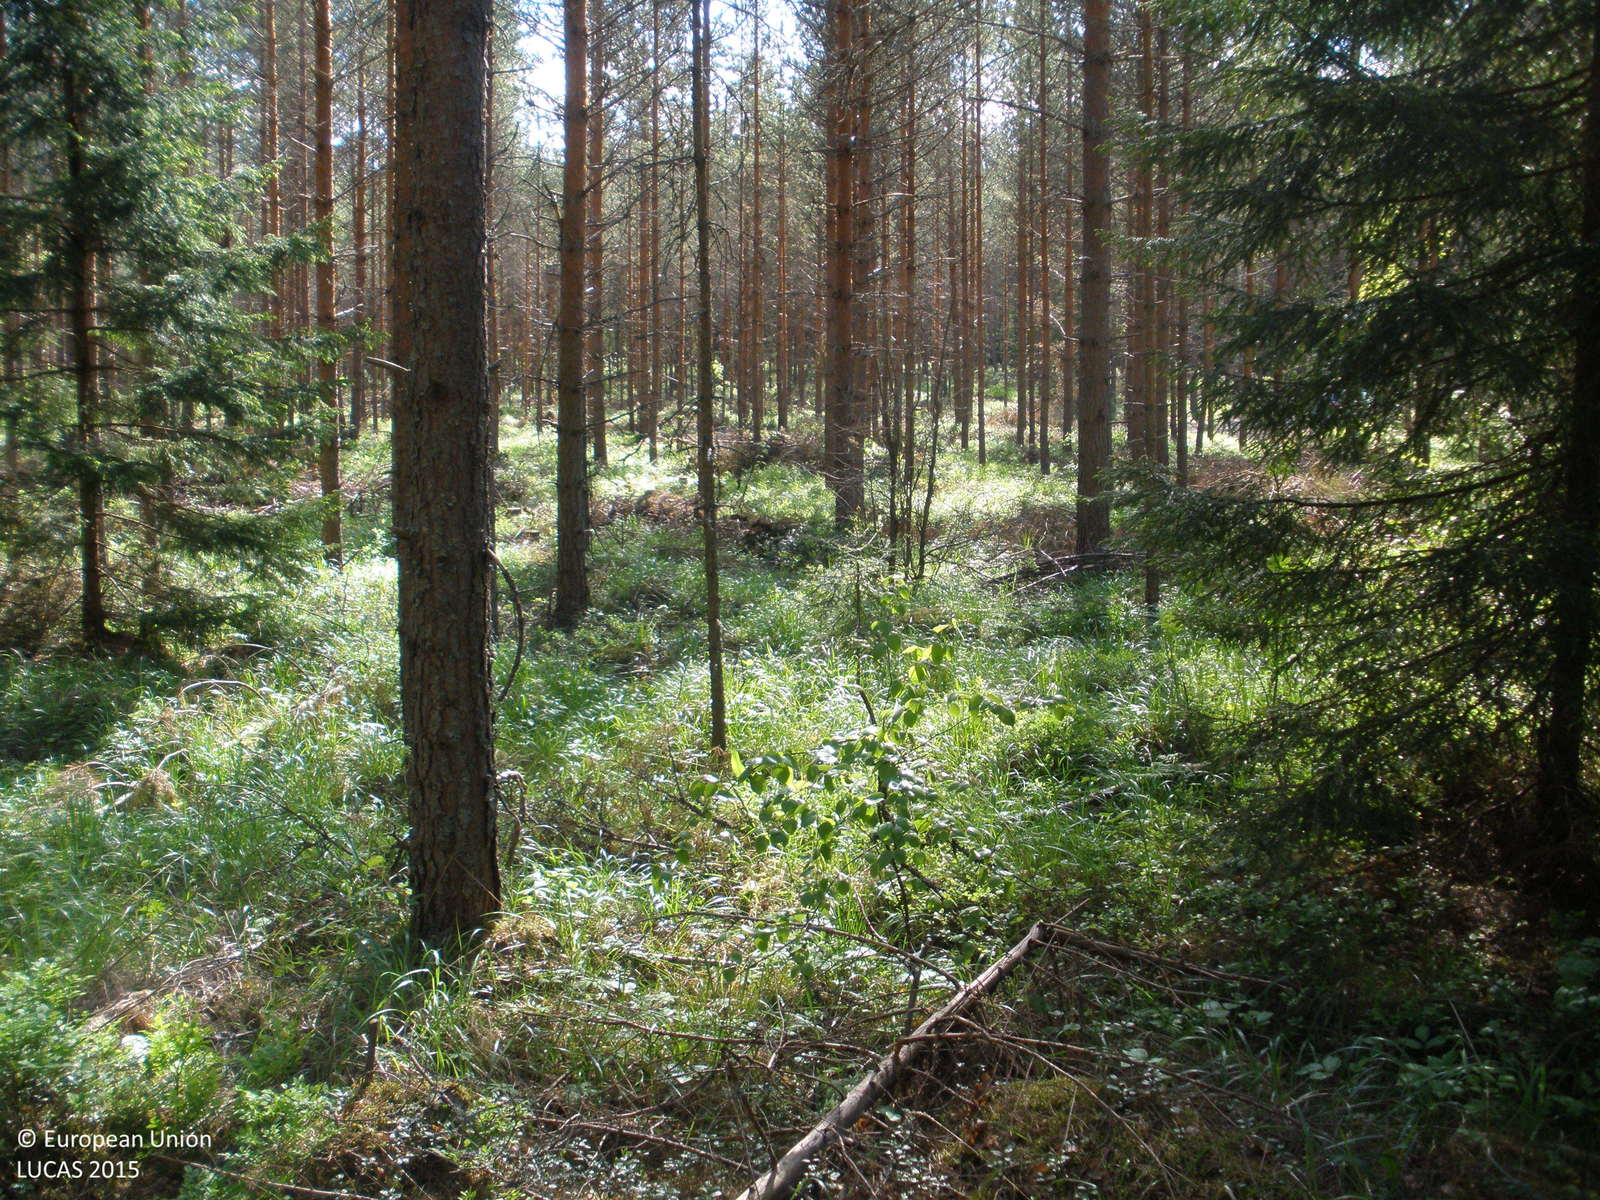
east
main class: Woodland
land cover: Pine dominated coniferous woodland
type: boreal forest
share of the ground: > 75 %
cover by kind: coniferous forest trees 80 %, lichens and mosses 10 %, broadleaved forest trees 5 %, herbaceous plants 5 %
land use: Forestry
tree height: > 5 m
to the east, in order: Pine dominated coniferous woodland; Tracks; Pine dominated coniferous woodland; Tracks; Pine dominated coniferous woodland; Tracks; Pine dominated coniferous woodland
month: June
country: FI
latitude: 60.7585
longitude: 24.0237
